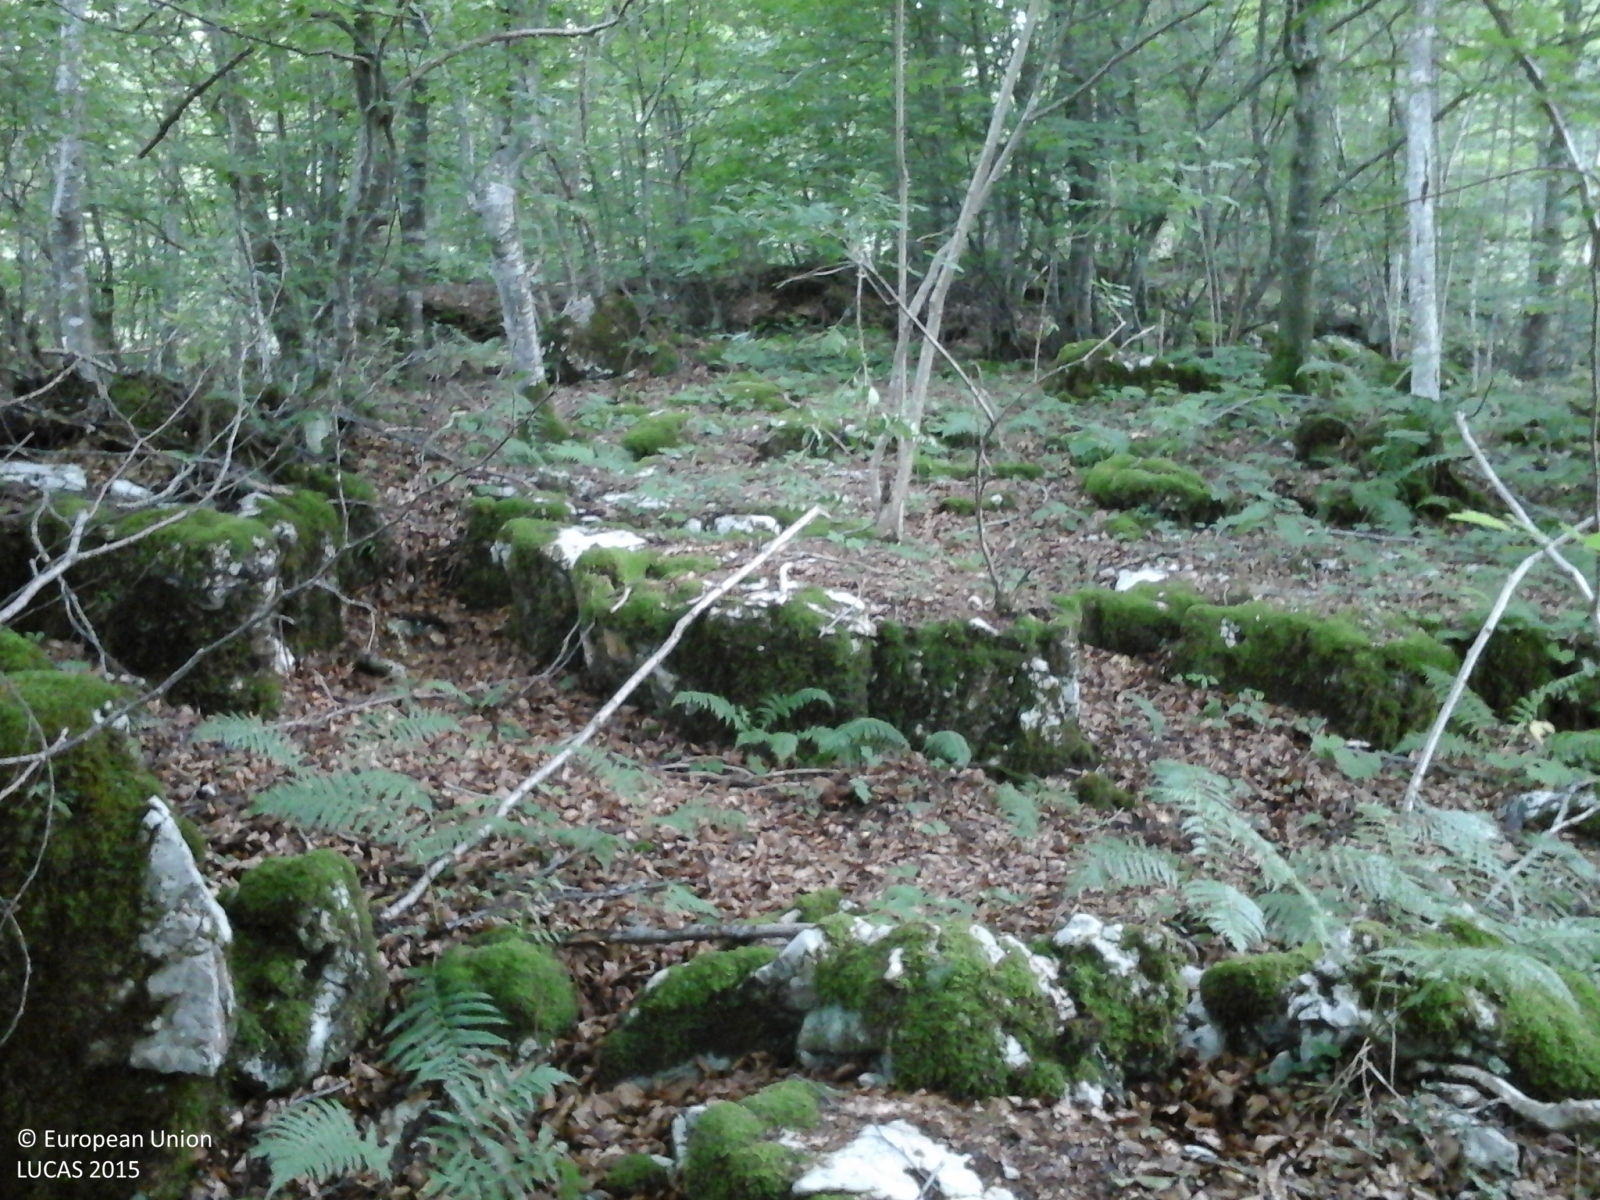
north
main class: Woodland
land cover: Broadleaved woodland
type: mountainous beech forest
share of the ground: > 75 %
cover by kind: broadleaved forest trees 100 %
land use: Forestry
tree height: > 5 m
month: June
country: IT
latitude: 45.8522
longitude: 11.6331
